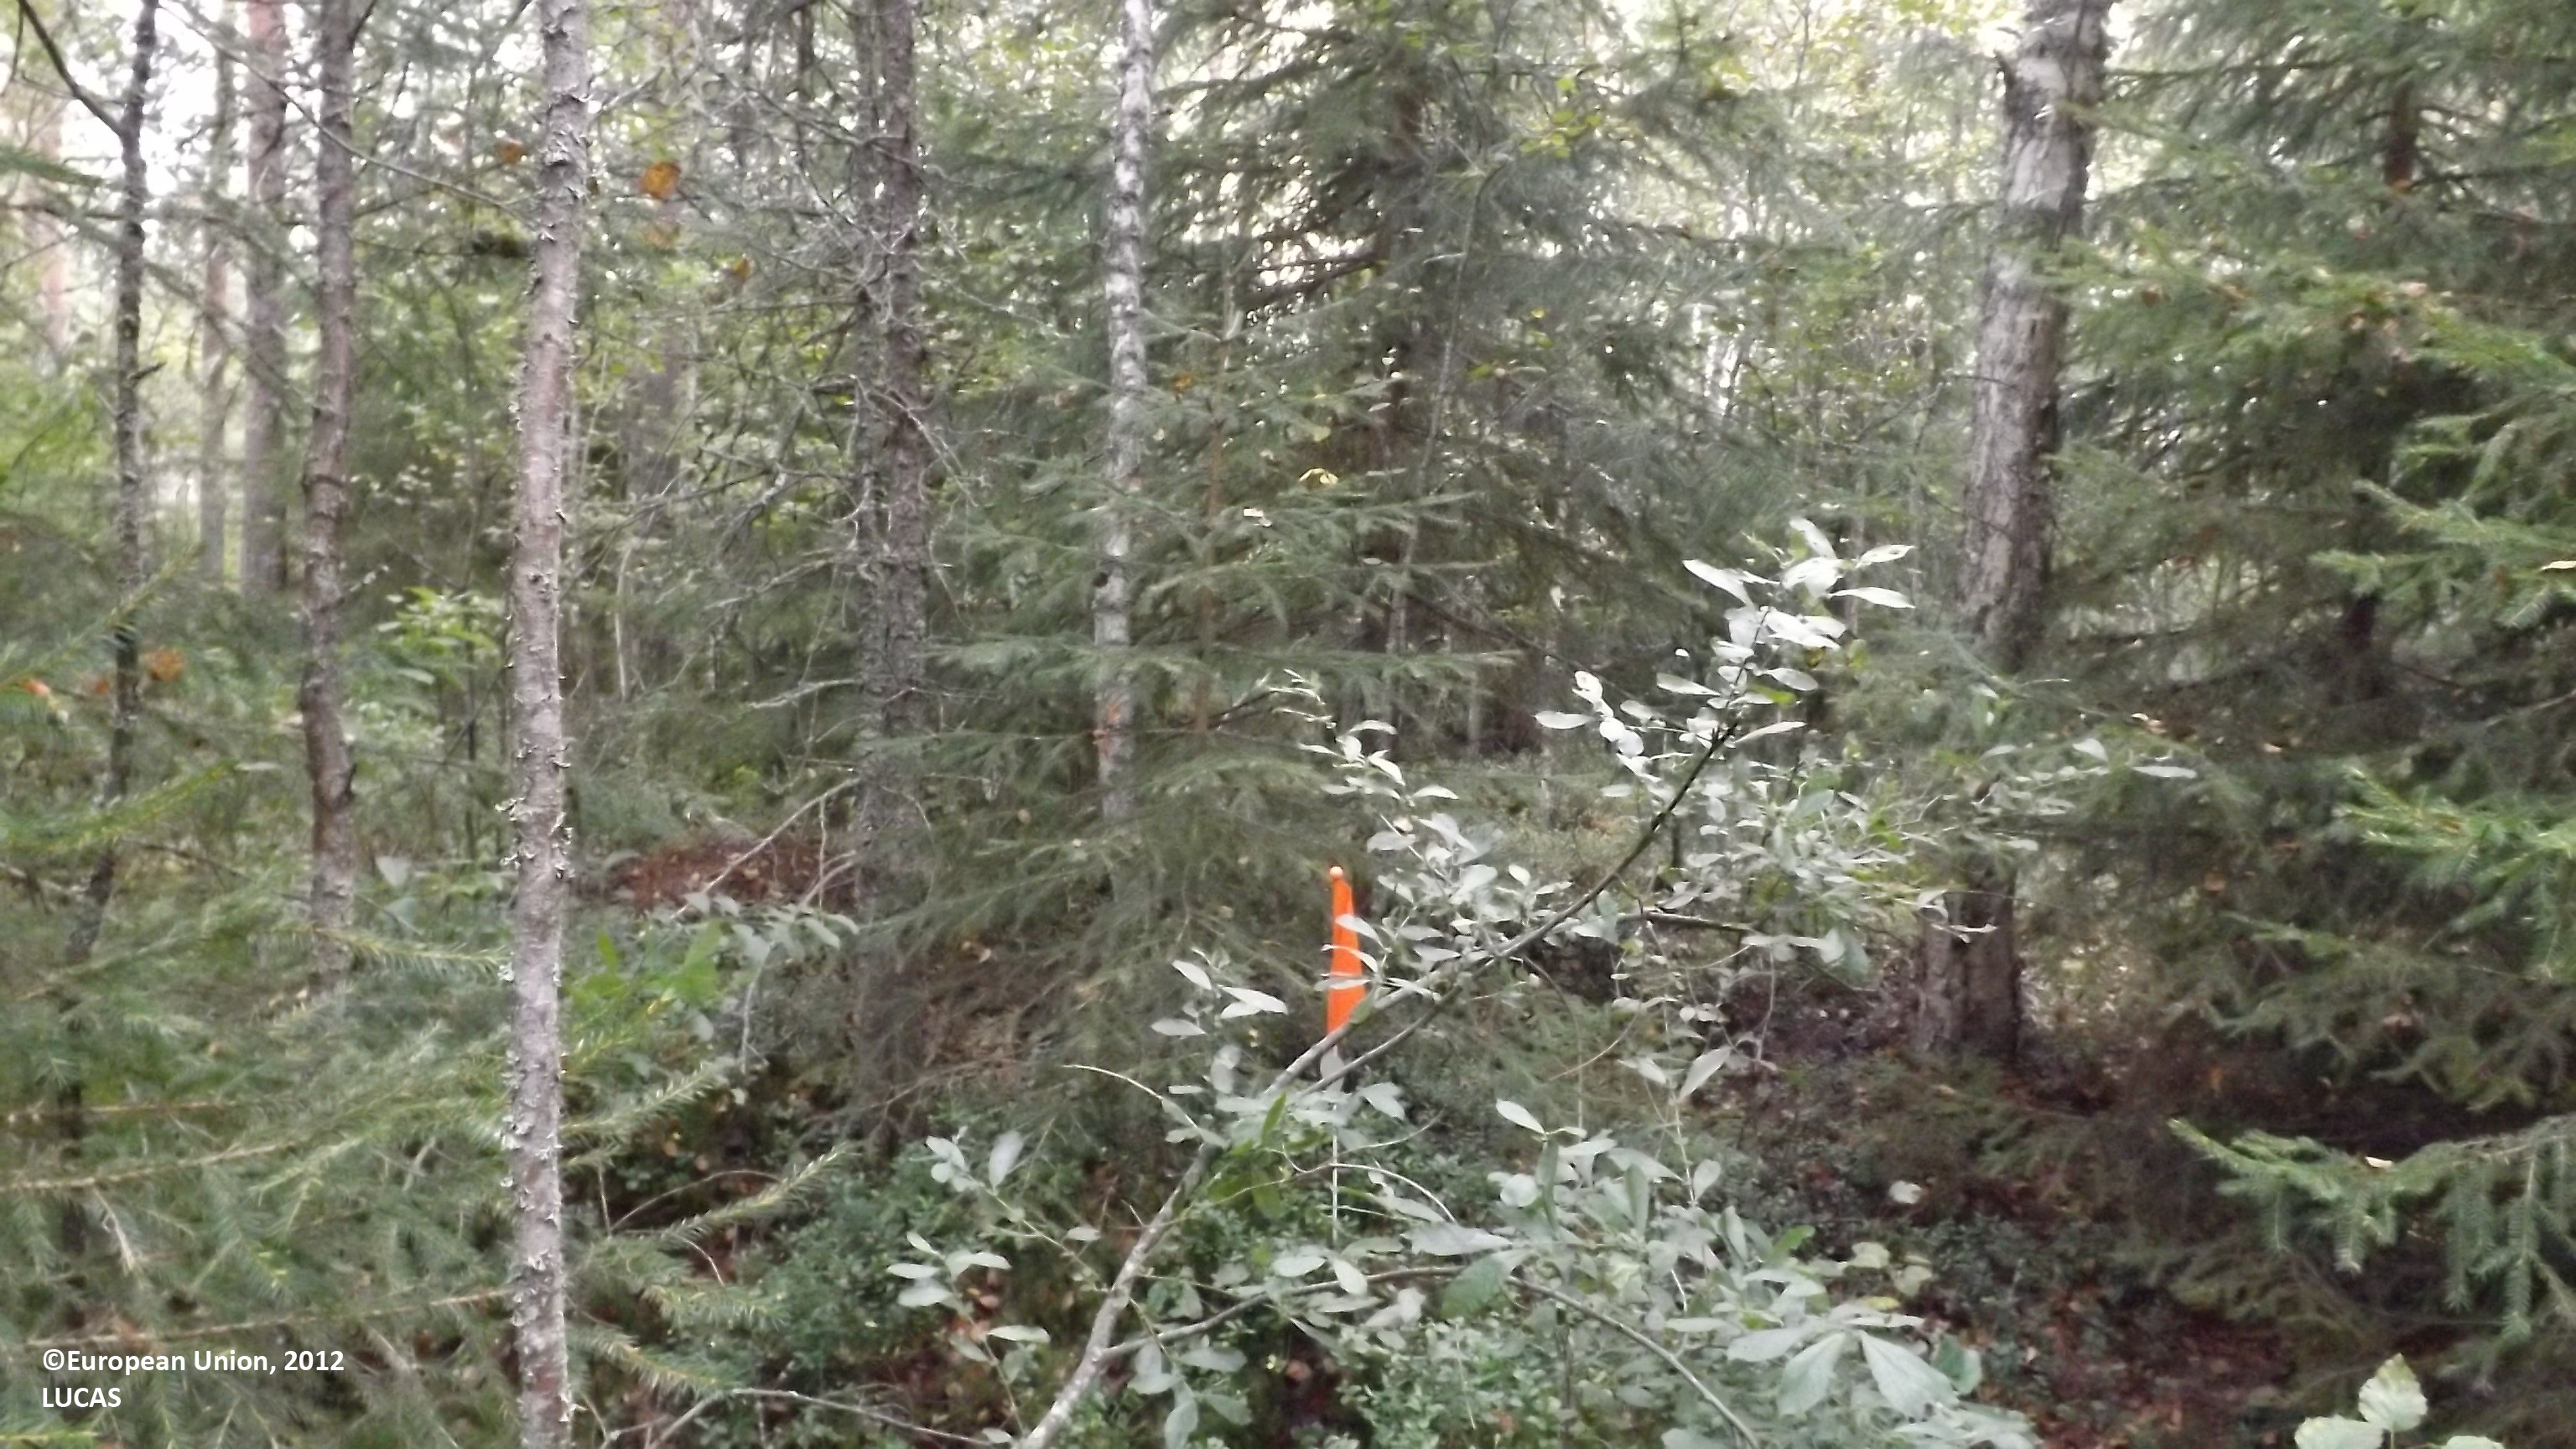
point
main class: Woodland
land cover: Other mixed woodland
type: boreal forest
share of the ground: > 75 %
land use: Forestry
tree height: > 5 m
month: August
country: FI
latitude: 63.8615
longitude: 24.0448
